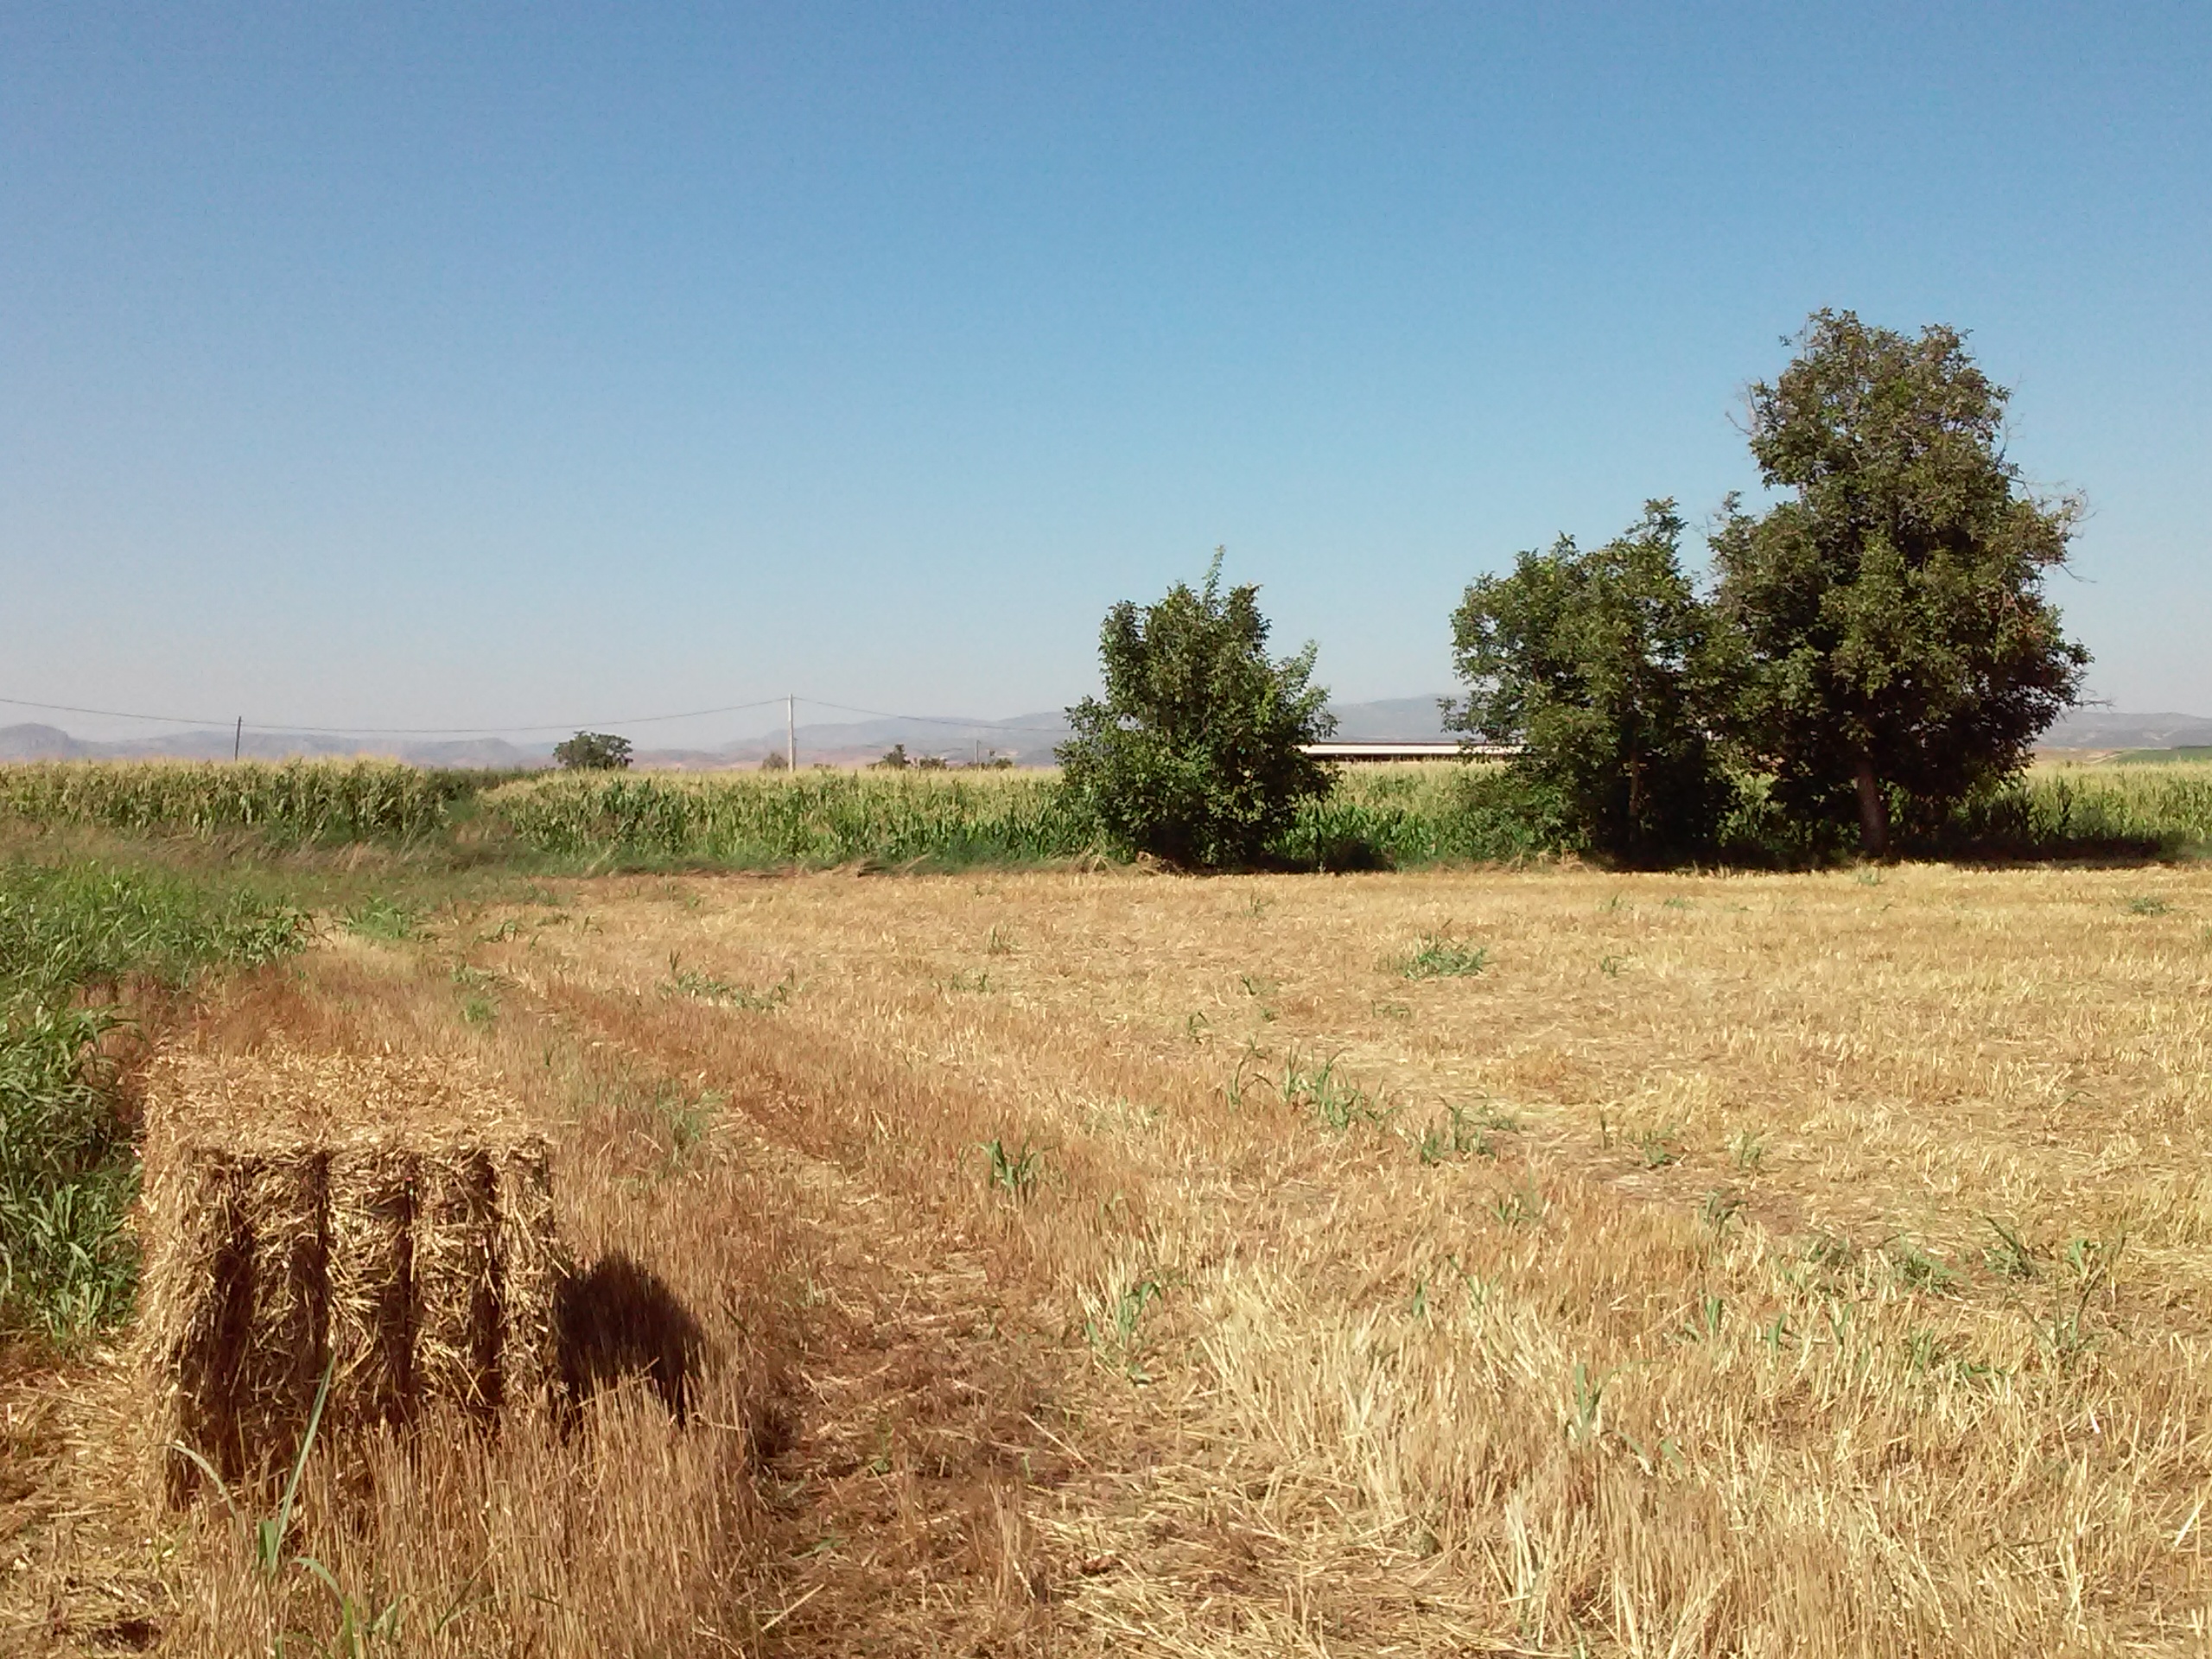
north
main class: Cropland
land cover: Common wheat
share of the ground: < 10 %
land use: Agriculture (excluding fallow land and kitchen gardens)
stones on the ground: 10 - 25 %
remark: Harvested field
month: July
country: ES
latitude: 41.7430
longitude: 0.5954
